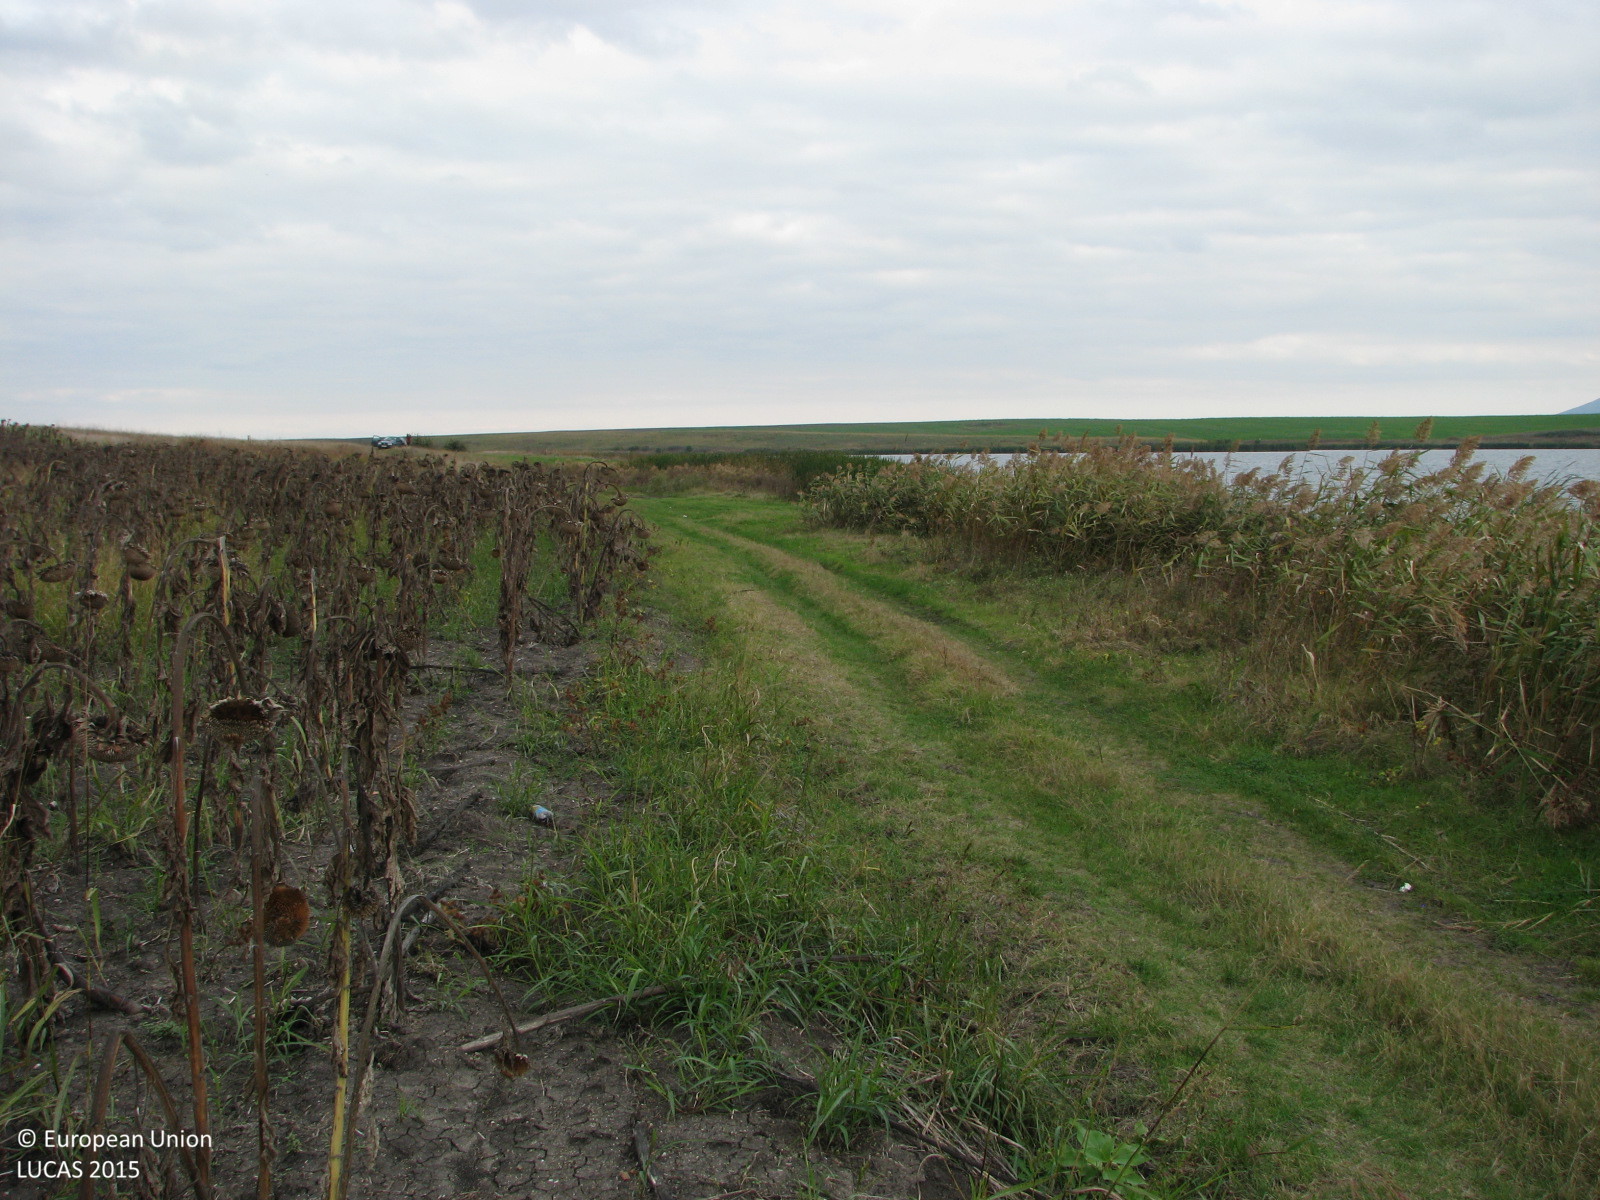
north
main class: Cropland
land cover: Sunflower
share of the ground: 50 - 75 %
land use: Agriculture (excluding fallow land and kitchen gardens)
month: October
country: BG
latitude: 42.2678
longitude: 26.1451
